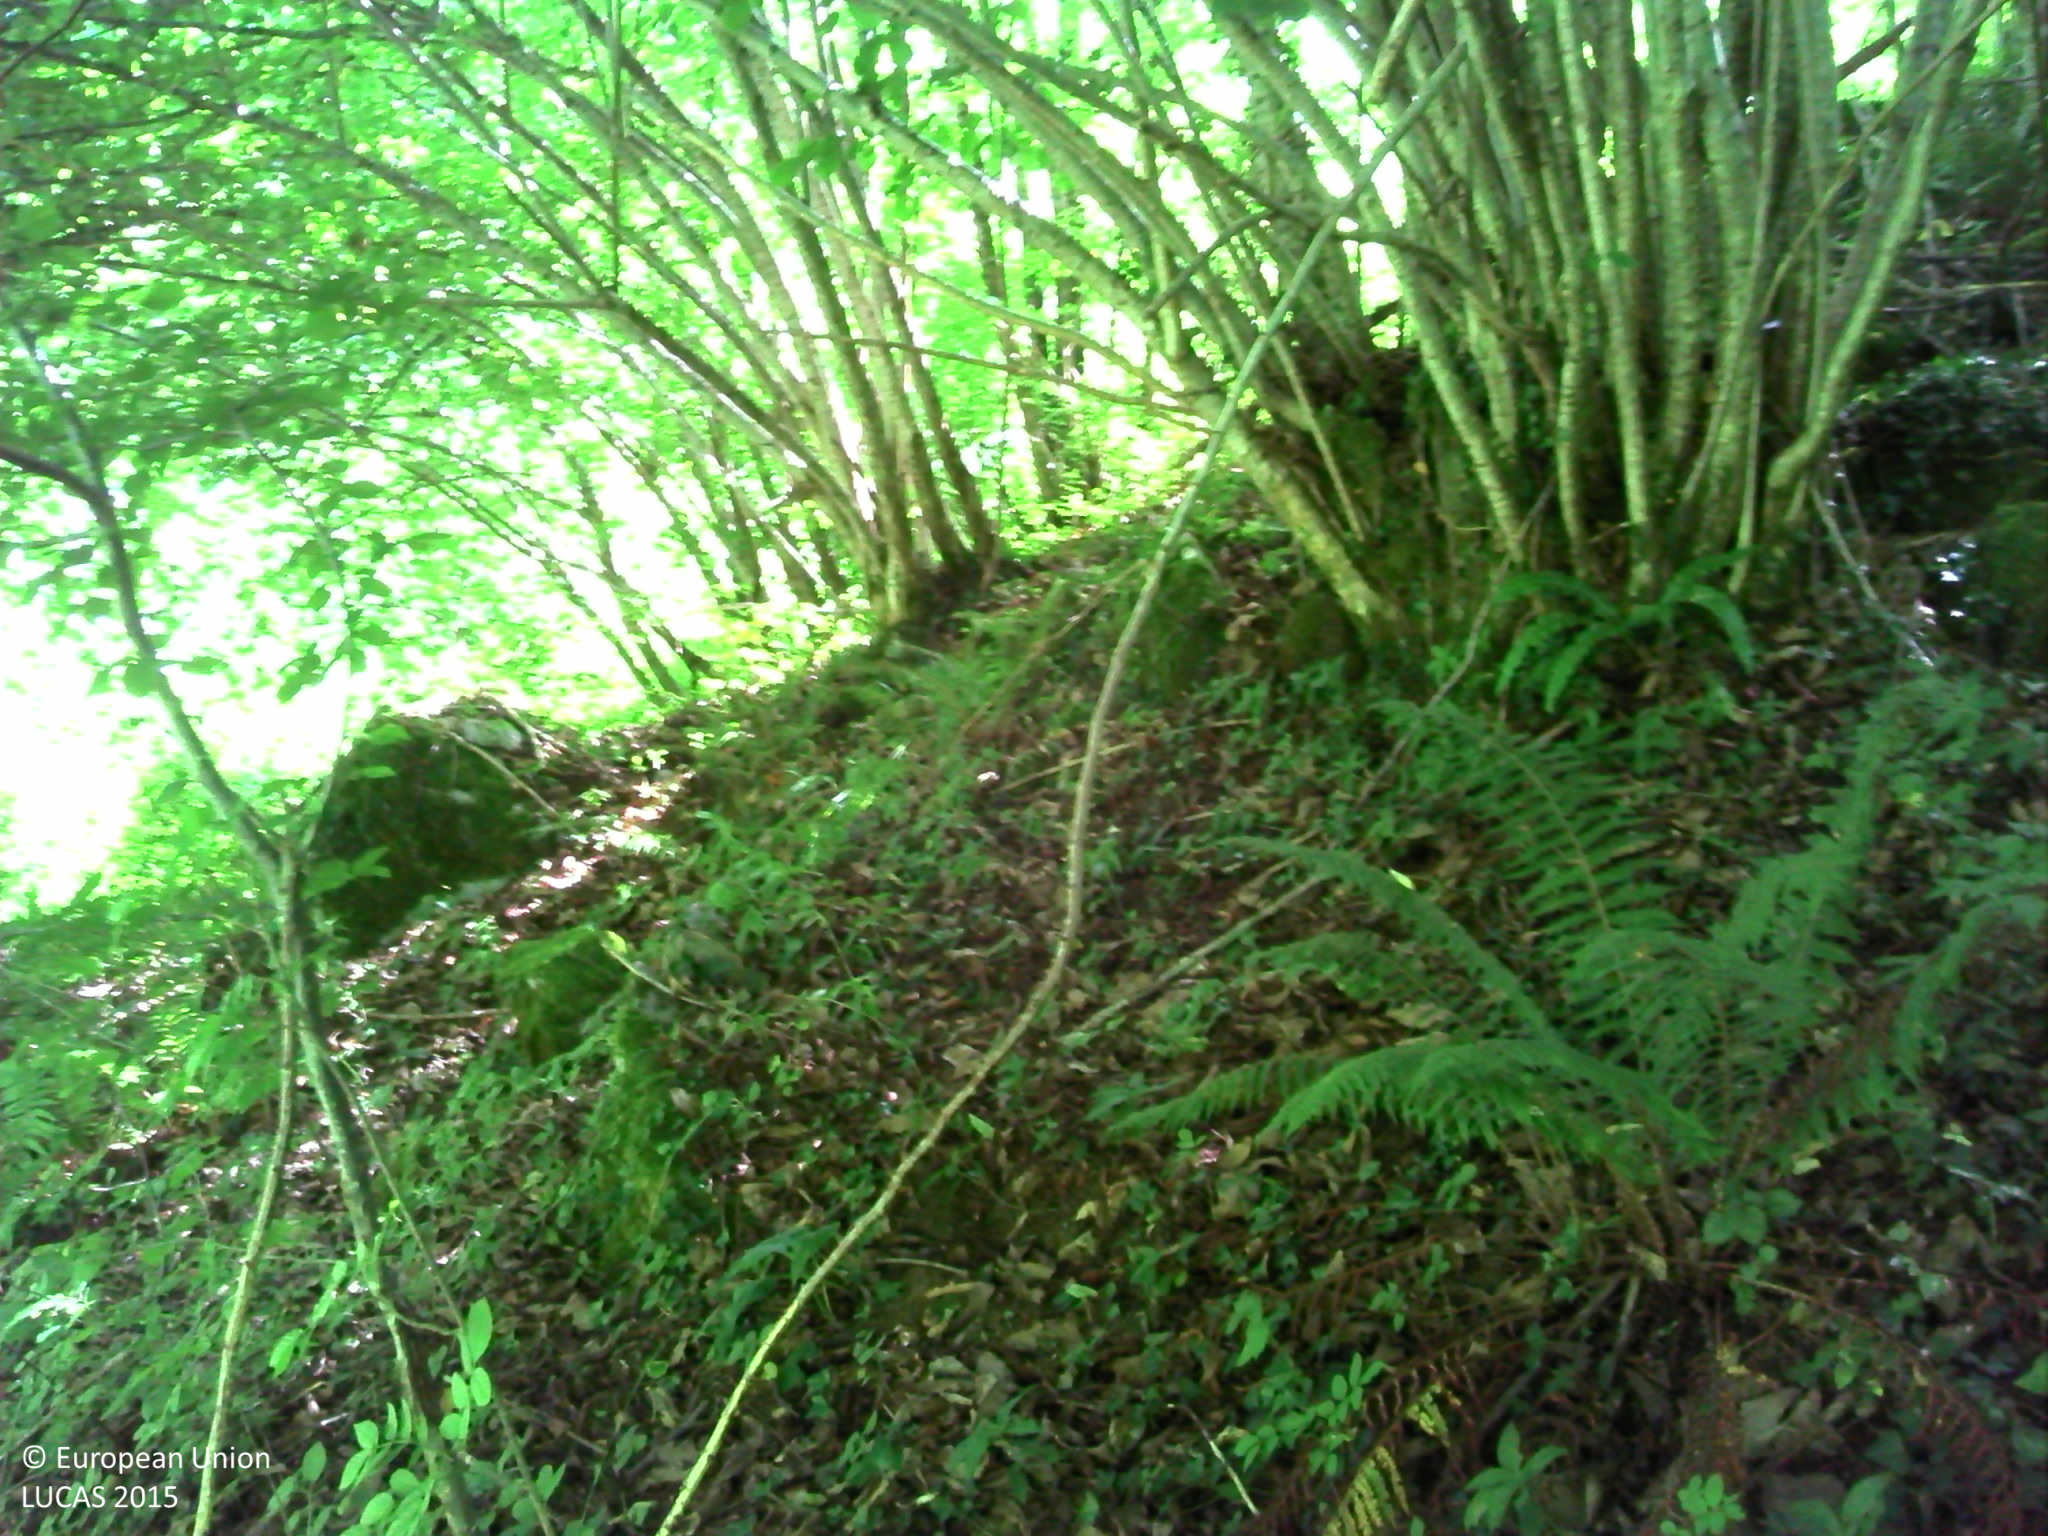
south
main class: Woodland
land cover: Broadleaved woodland
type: mesophytic deciduous forest
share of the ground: > 75 %
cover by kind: broadleaved forest trees 50 %, consolidated bare surface 30 %, shrubs 10 %, herbaceous plants 10 %
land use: Forestry
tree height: > 5 m
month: July
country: FR
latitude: 42.9695
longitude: 0.8940
